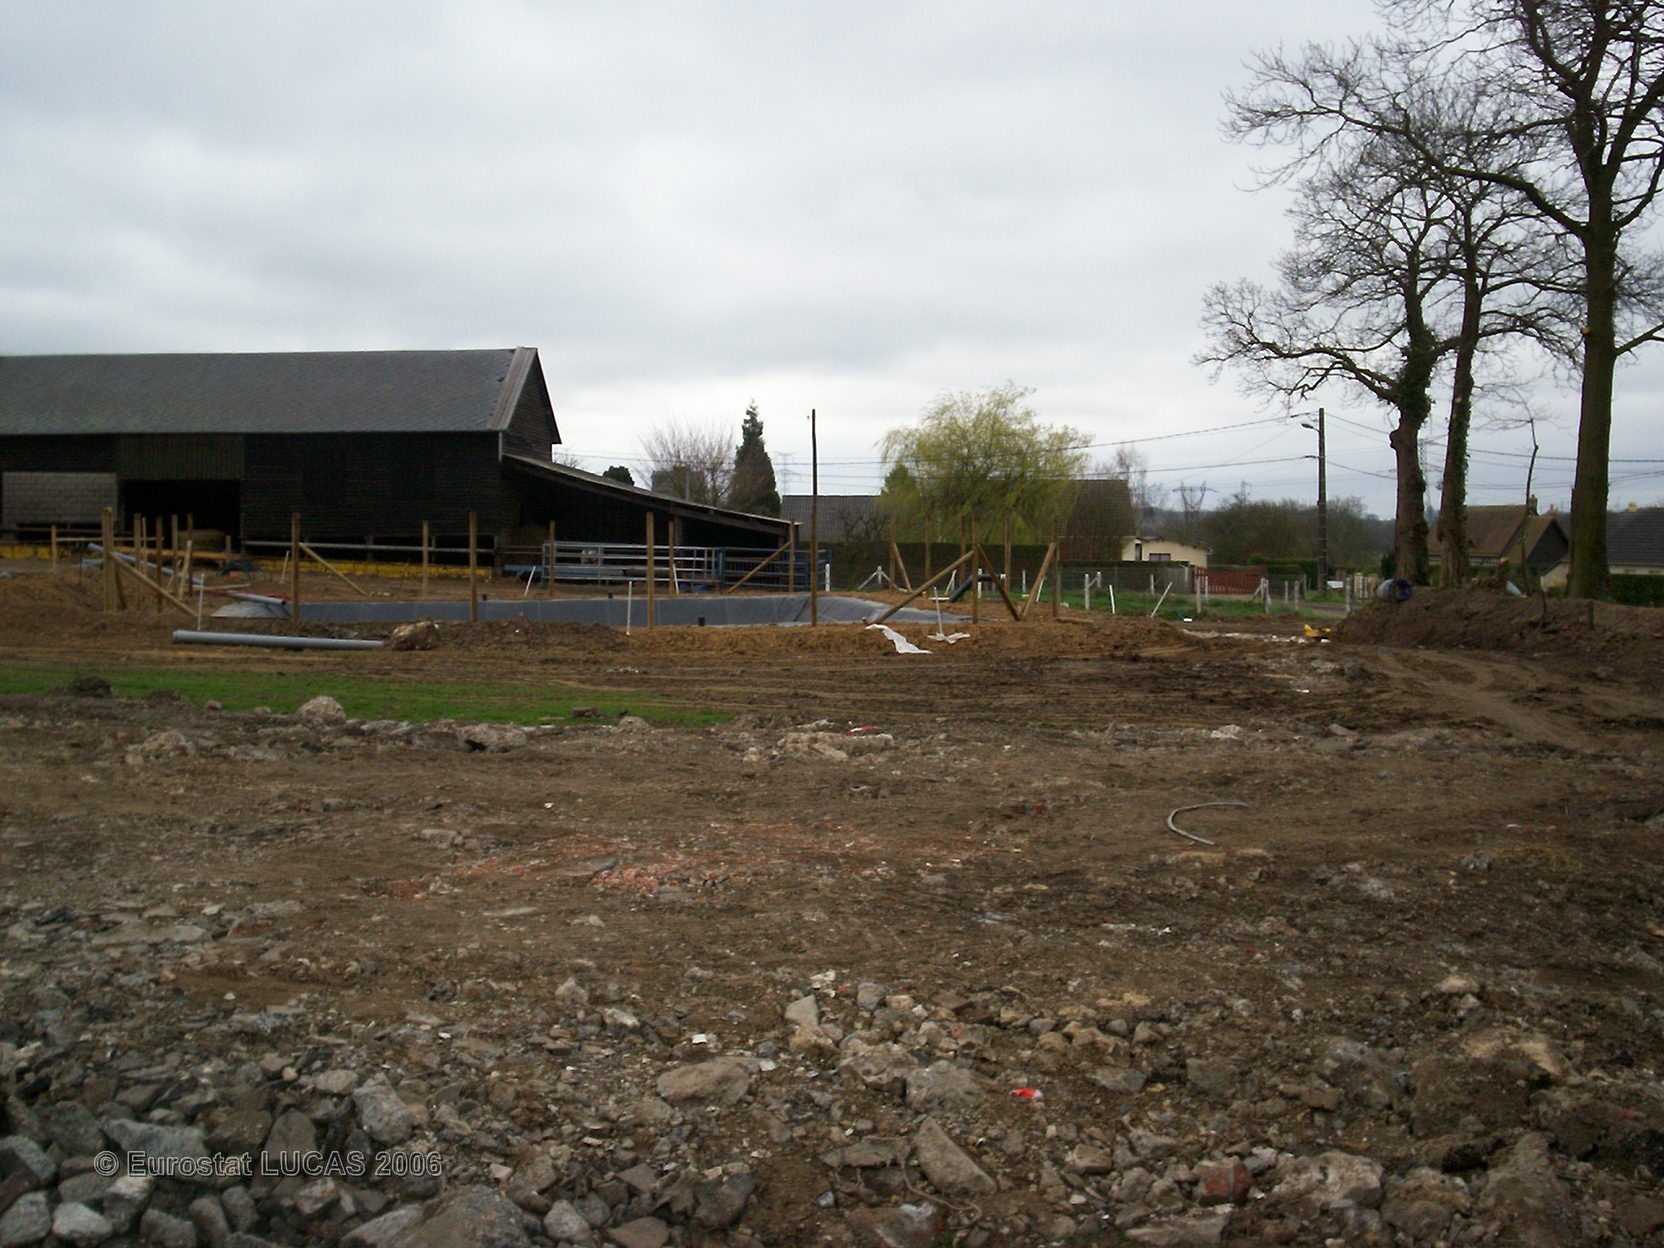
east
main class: Grassland
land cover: Grassland without tree/shrub cover
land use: Agriculture (excluding fallow land and kitchen gardens)
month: April
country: FR
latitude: 49.4988
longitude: 0.9610
